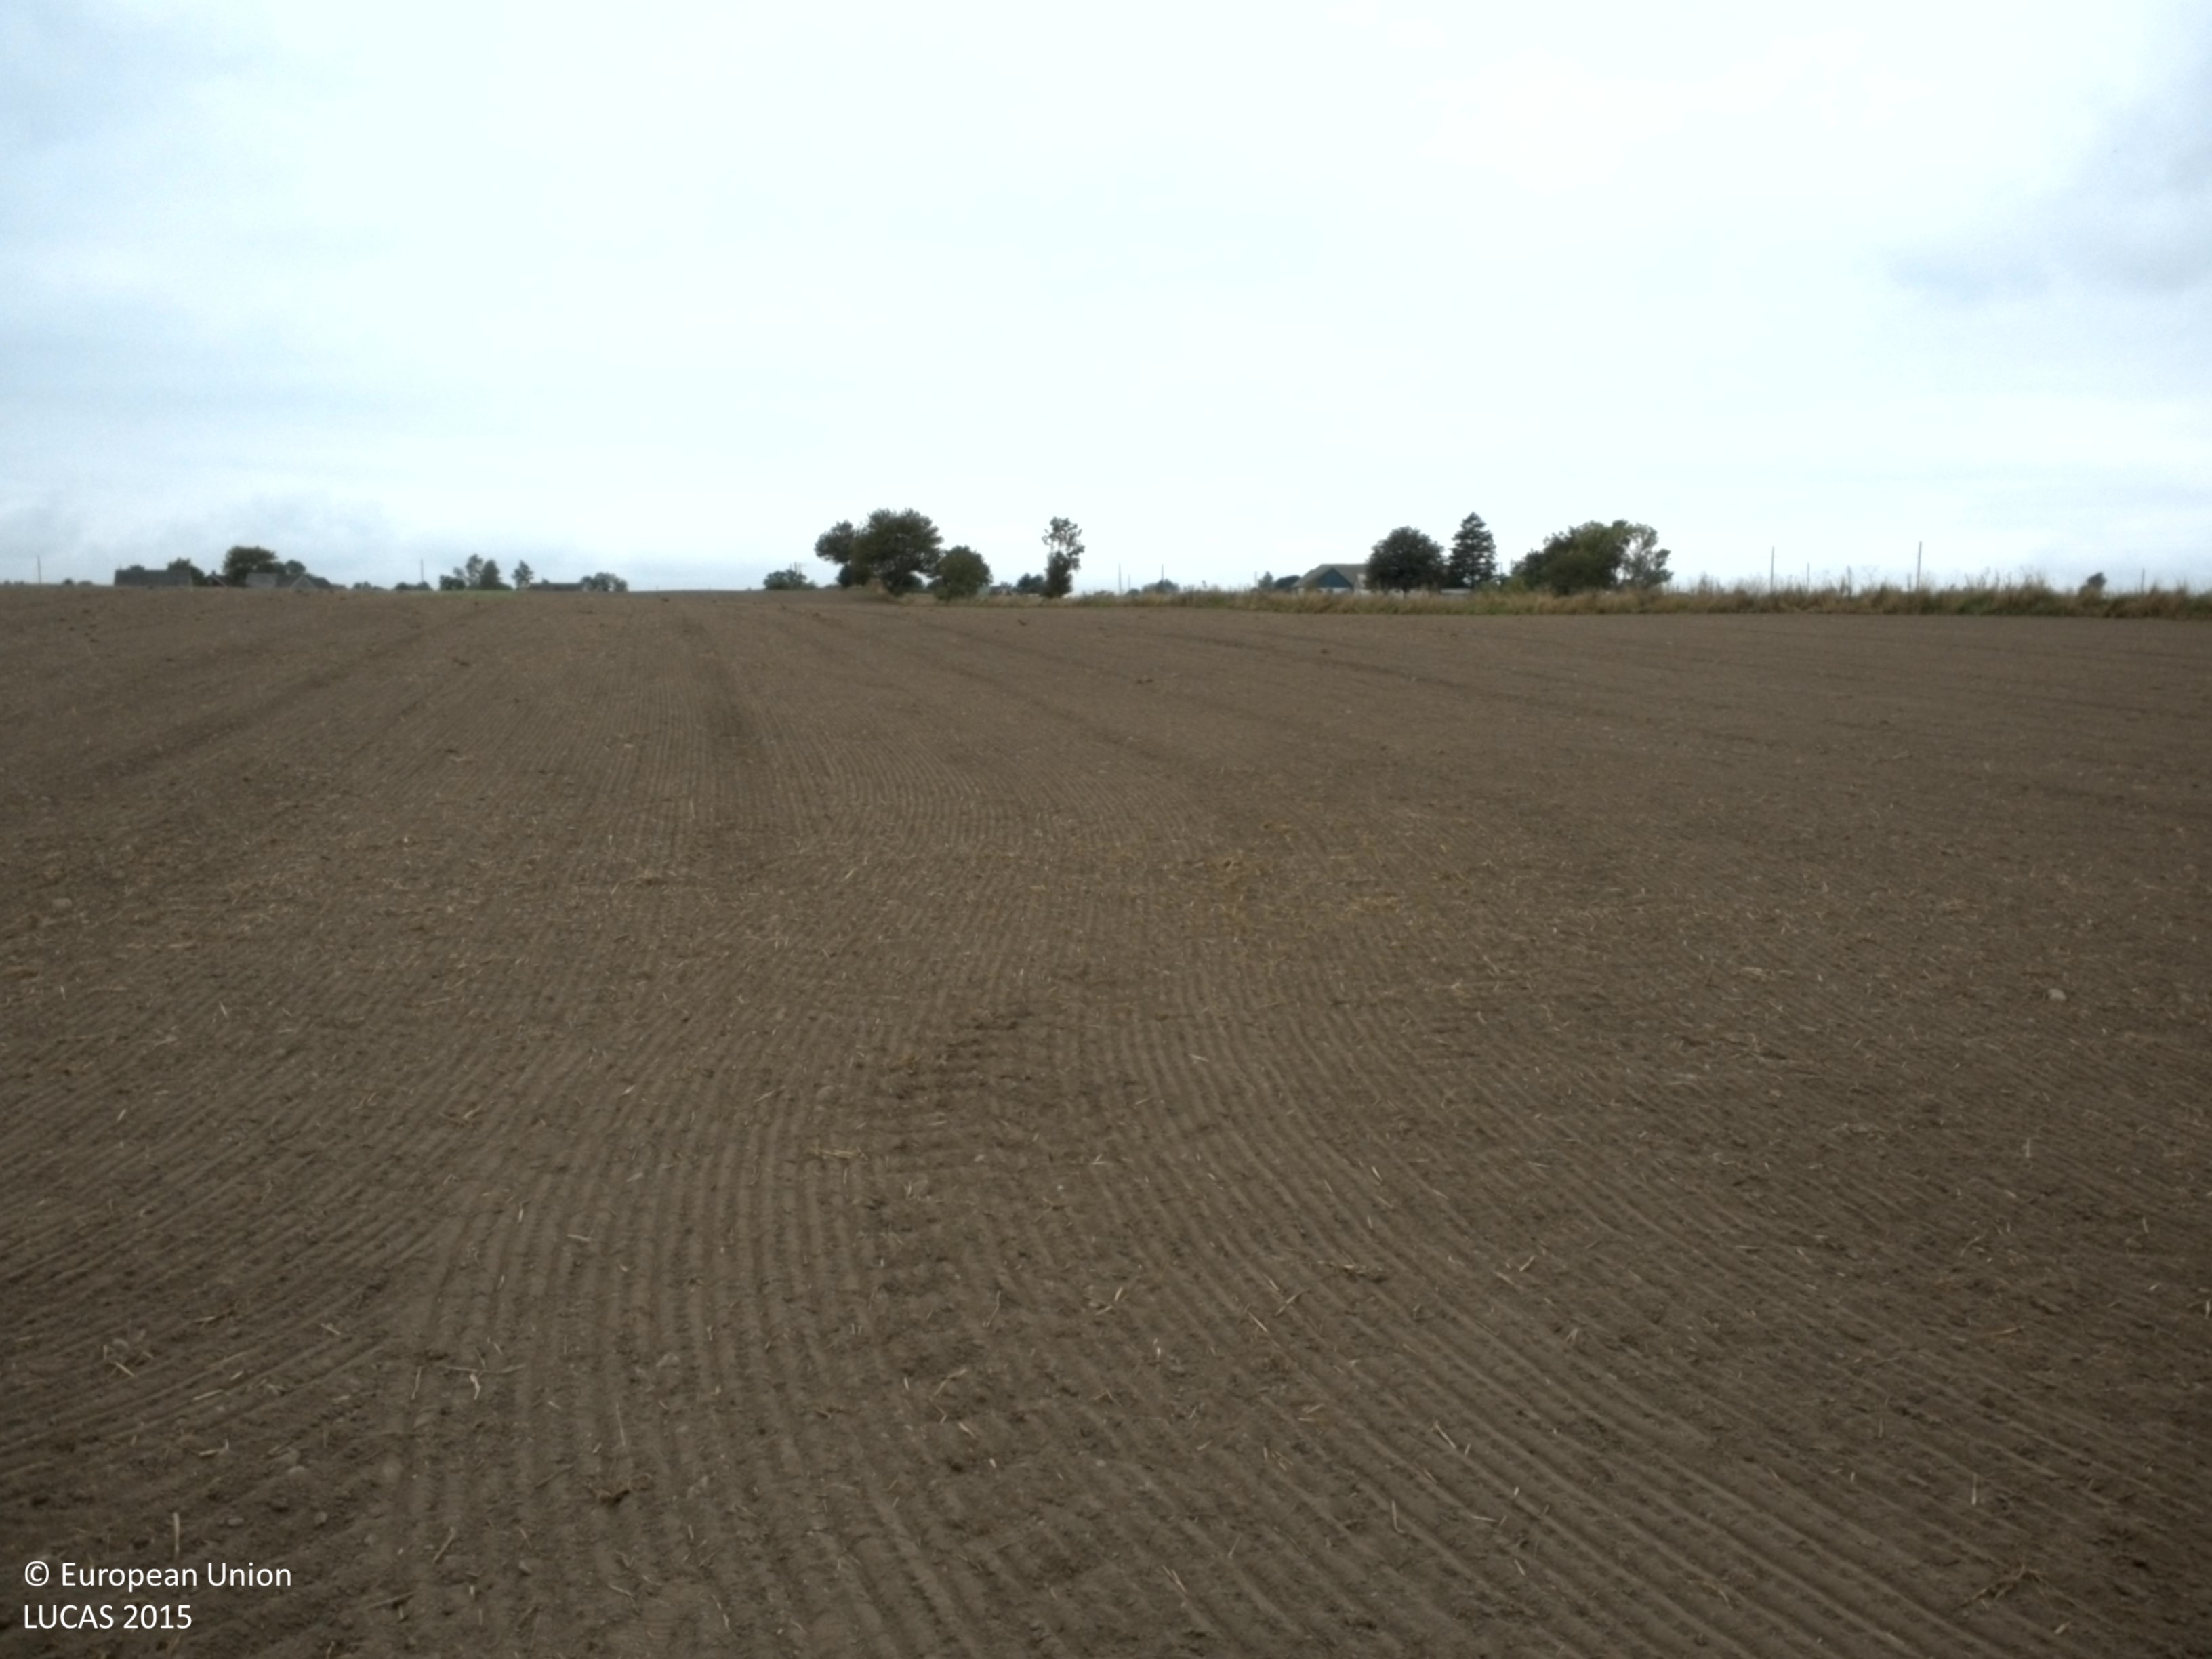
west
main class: Cropland
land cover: Common wheat
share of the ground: < 10 %
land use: Agriculture (excluding fallow land and kitchen gardens)
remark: Tilled/Sowed
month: October
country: SE
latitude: 55.5662
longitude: 14.0421
